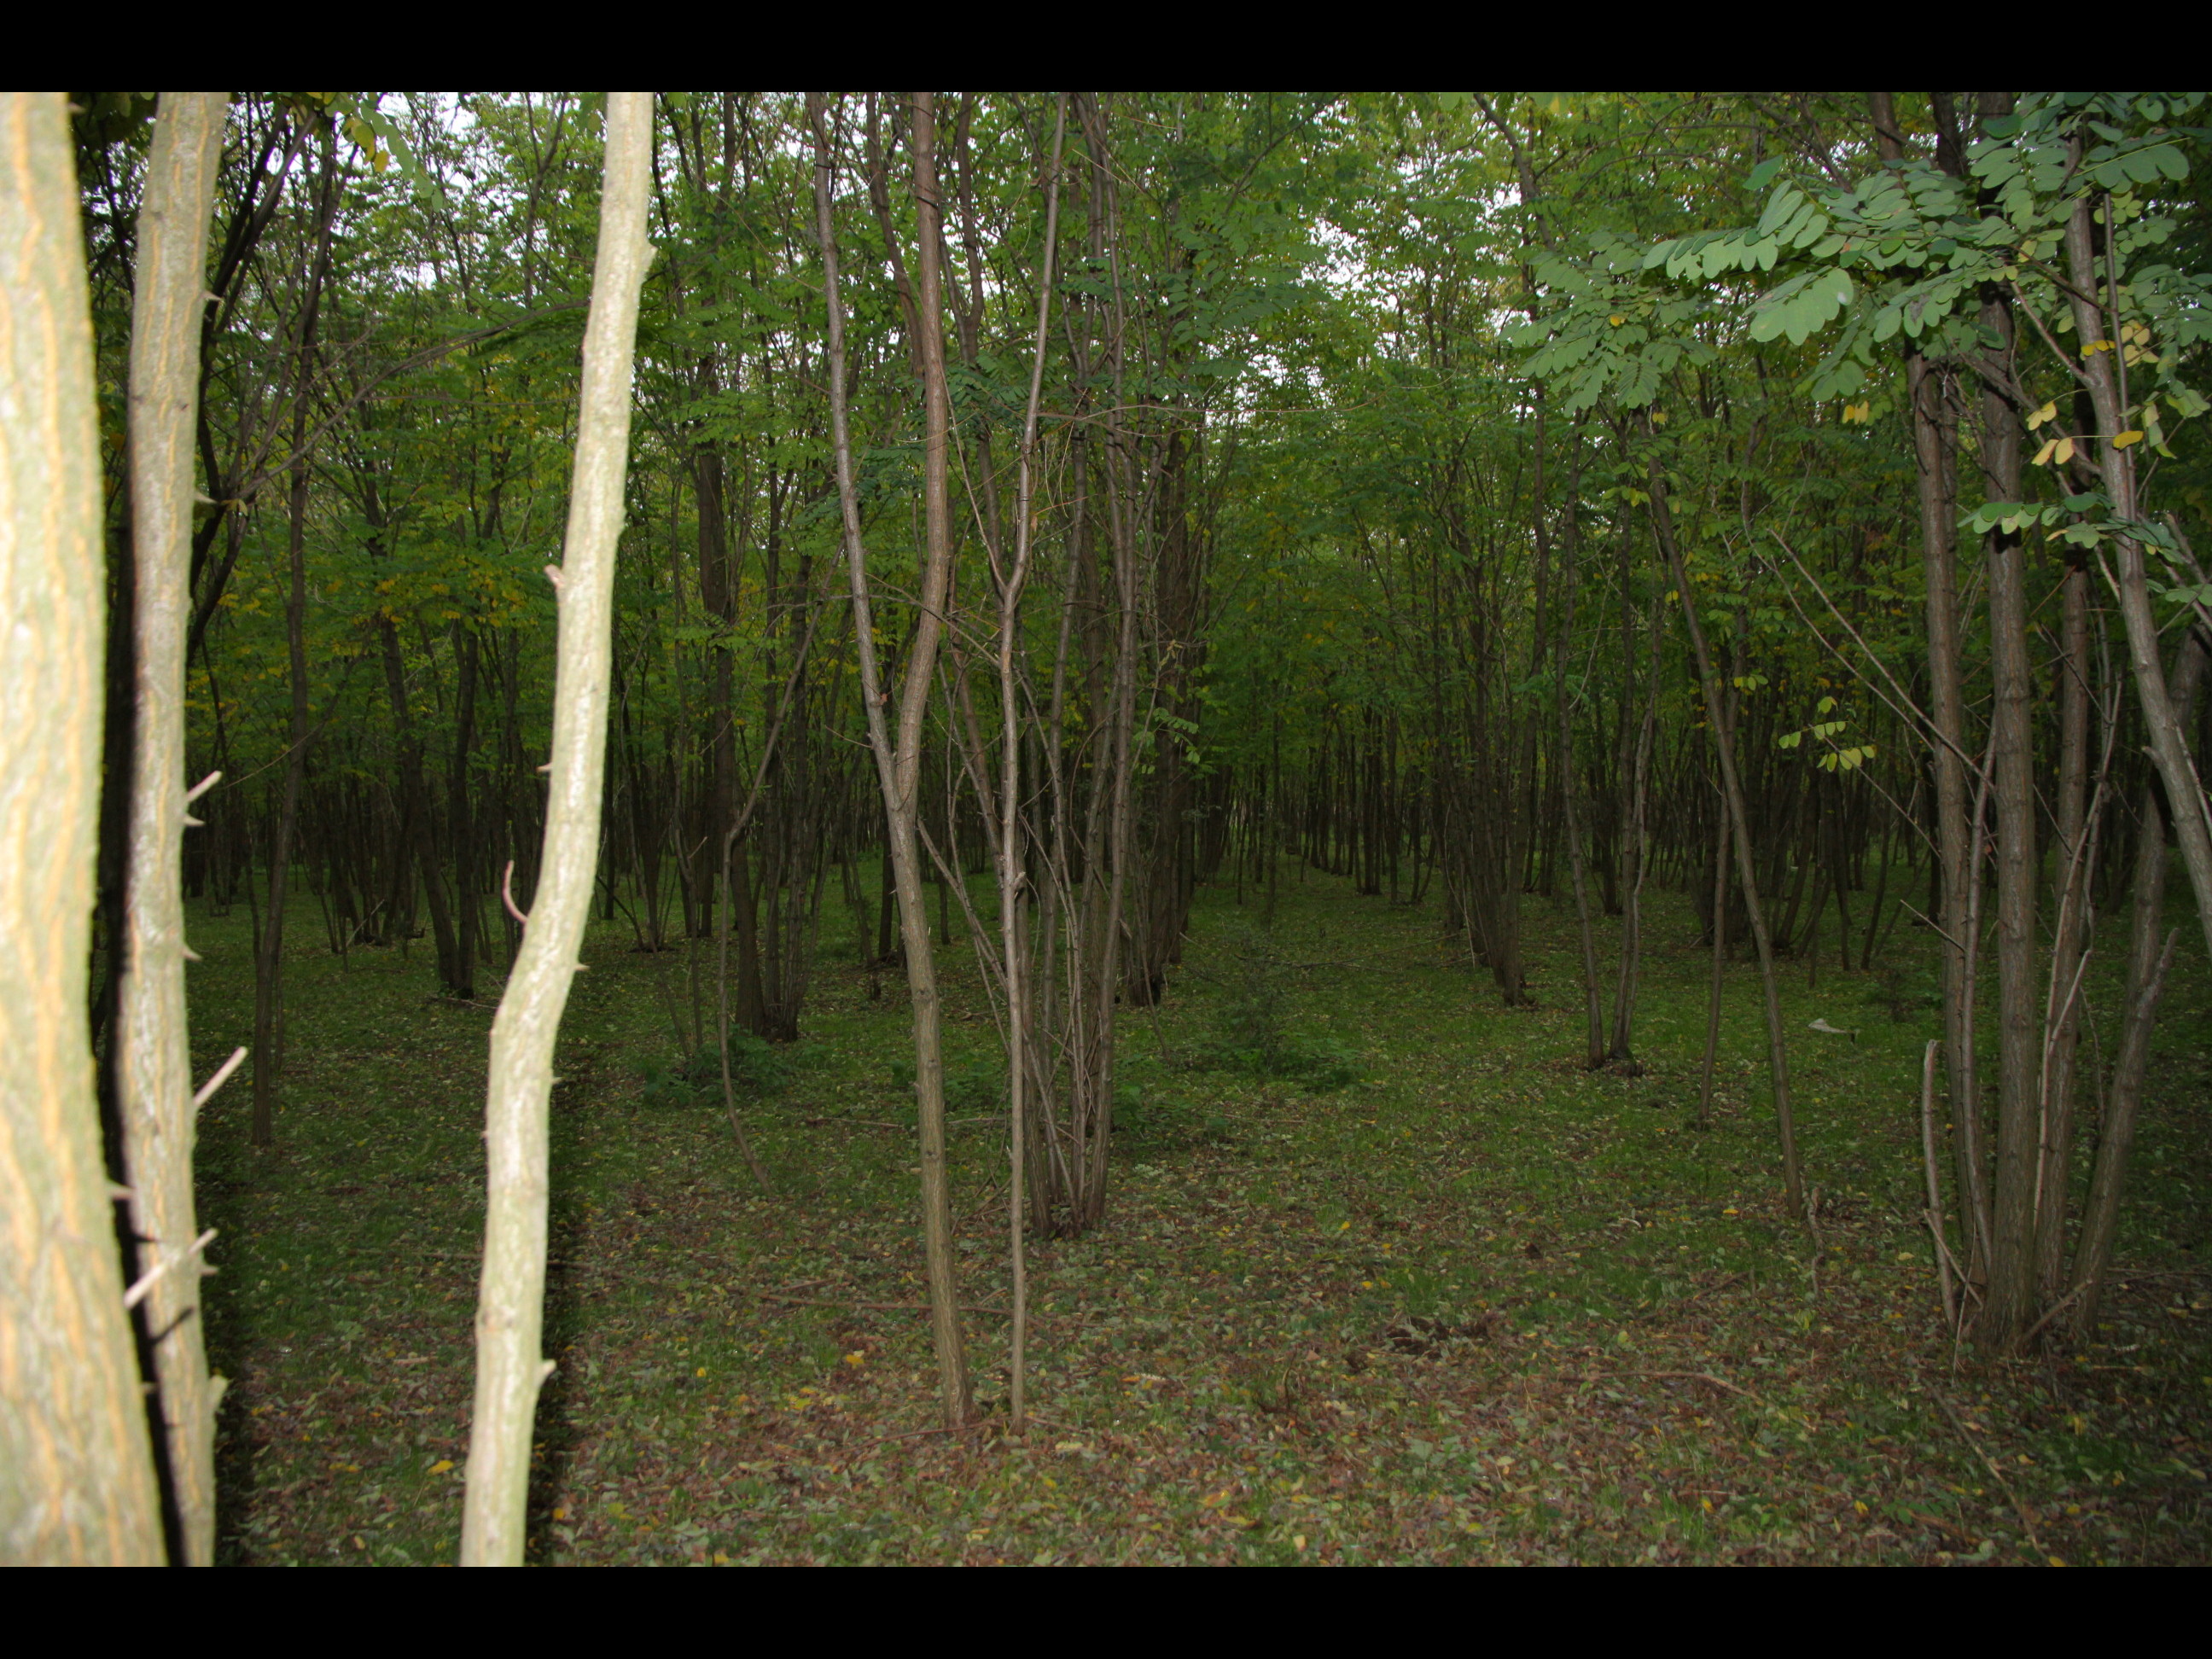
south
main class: Woodland
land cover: Broadleaved woodland
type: thermophilous deciduous forest
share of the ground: > 75 %
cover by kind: broadleaved forest trees 100 %
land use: Forestry
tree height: > 5 m
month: October
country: BG
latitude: 43.6808
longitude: 27.0532
